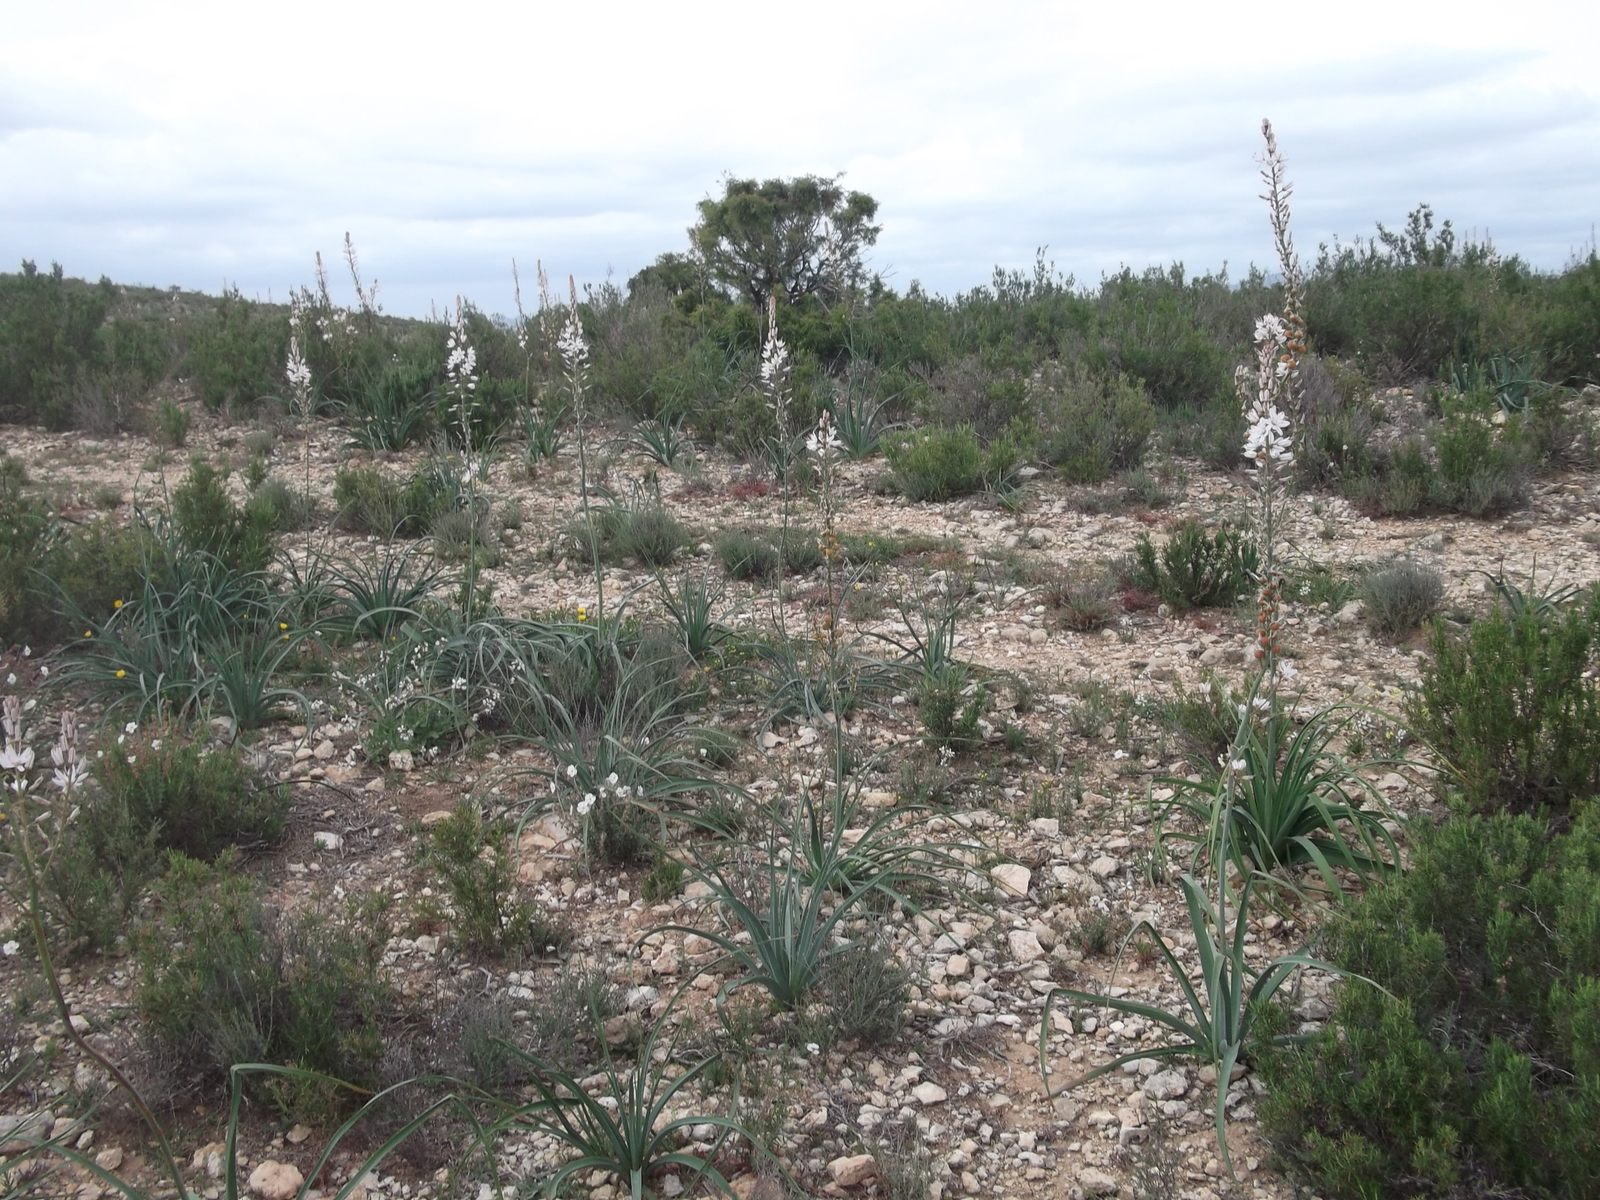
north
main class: Shrubland
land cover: Shrubland without tree cover
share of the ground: 10 - 25 %
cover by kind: herbaceous plants 75 %, shrubs 25 %
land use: Abandoned areas
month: April
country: ES
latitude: 38.0652
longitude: -1.5560
